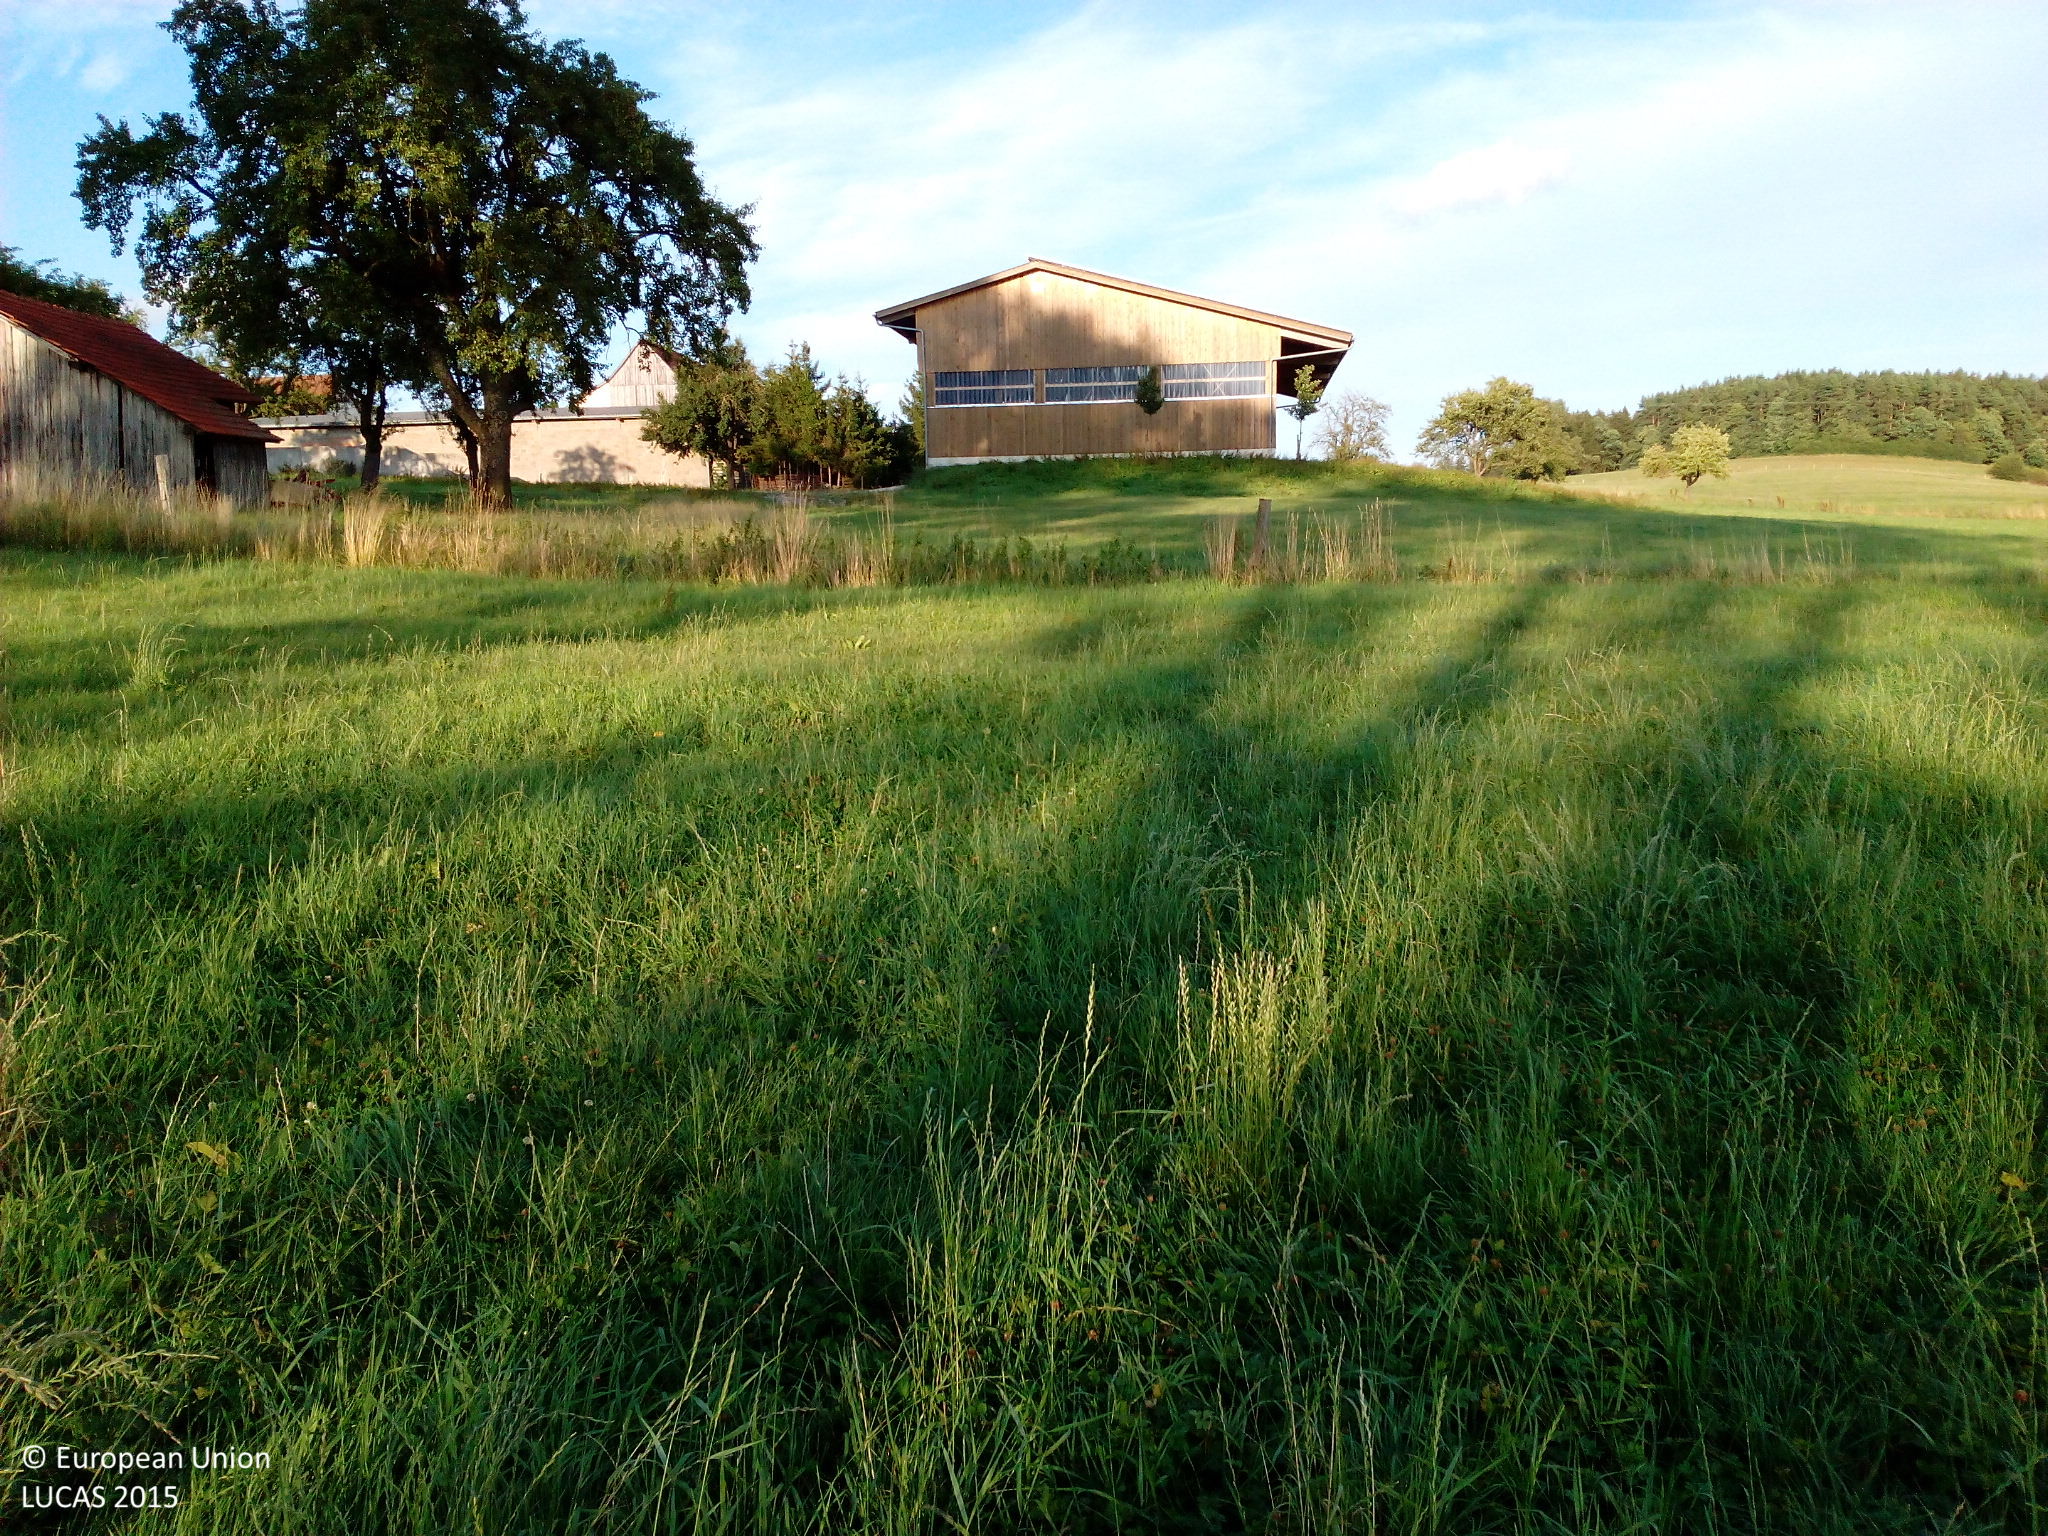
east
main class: Grassland
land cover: Grassland without tree/shrub cover
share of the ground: > 75 %
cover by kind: herbaceous plants 100 %
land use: Agriculture (excluding fallow land and kitchen gardens)
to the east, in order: Grassland without tree/shrub cover; Artificial constructions in urban areas; Grassland without tree/shrub cover; Apple fruit; Tracks; Grassland without tree/shrub cover
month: July
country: DE
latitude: 48.9429
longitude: 10.2593
